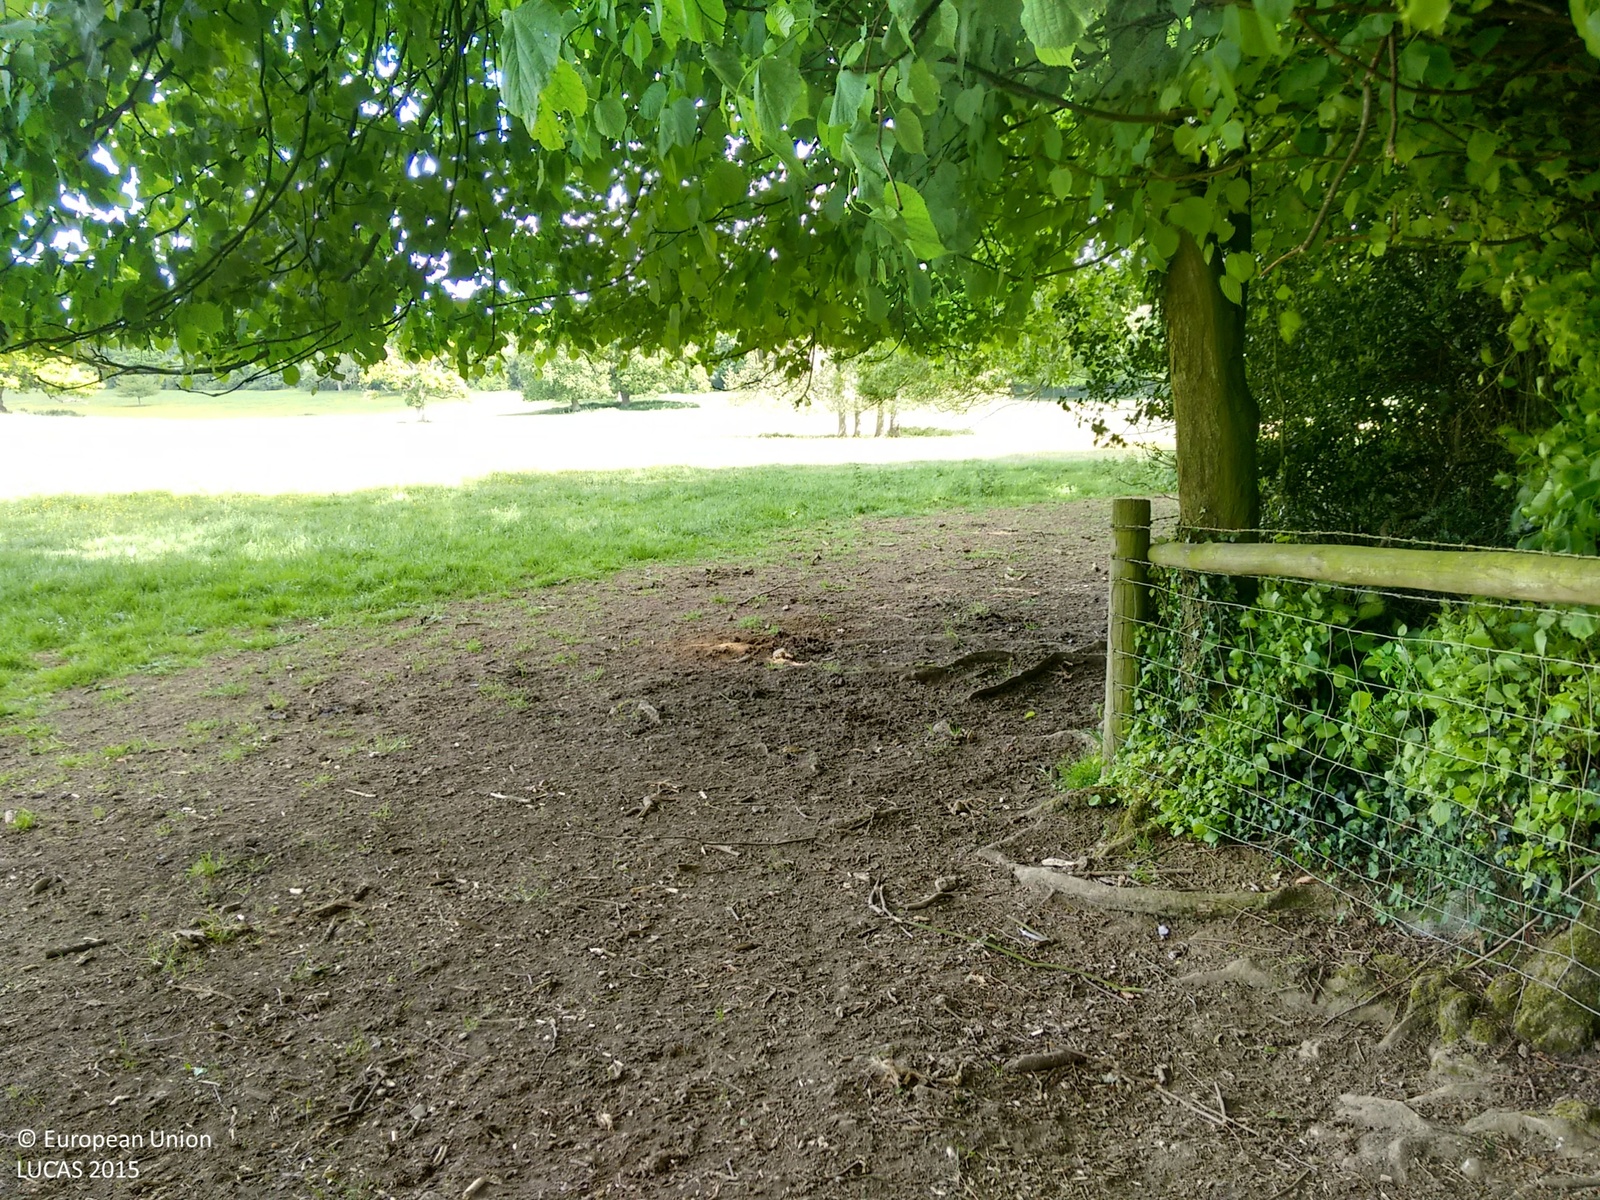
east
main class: Grassland
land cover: Grassland without tree/shrub cover
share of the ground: > 75 %
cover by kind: herbaceous plants 100 %
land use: Agriculture (excluding fallow land and kitchen gardens)
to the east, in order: Grassland without tree/shrub cover; Single bushes/trees; Grassland without tree/shrub cover; Managed hedges
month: May
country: GB
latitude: 51.2340
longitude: 1.1699
